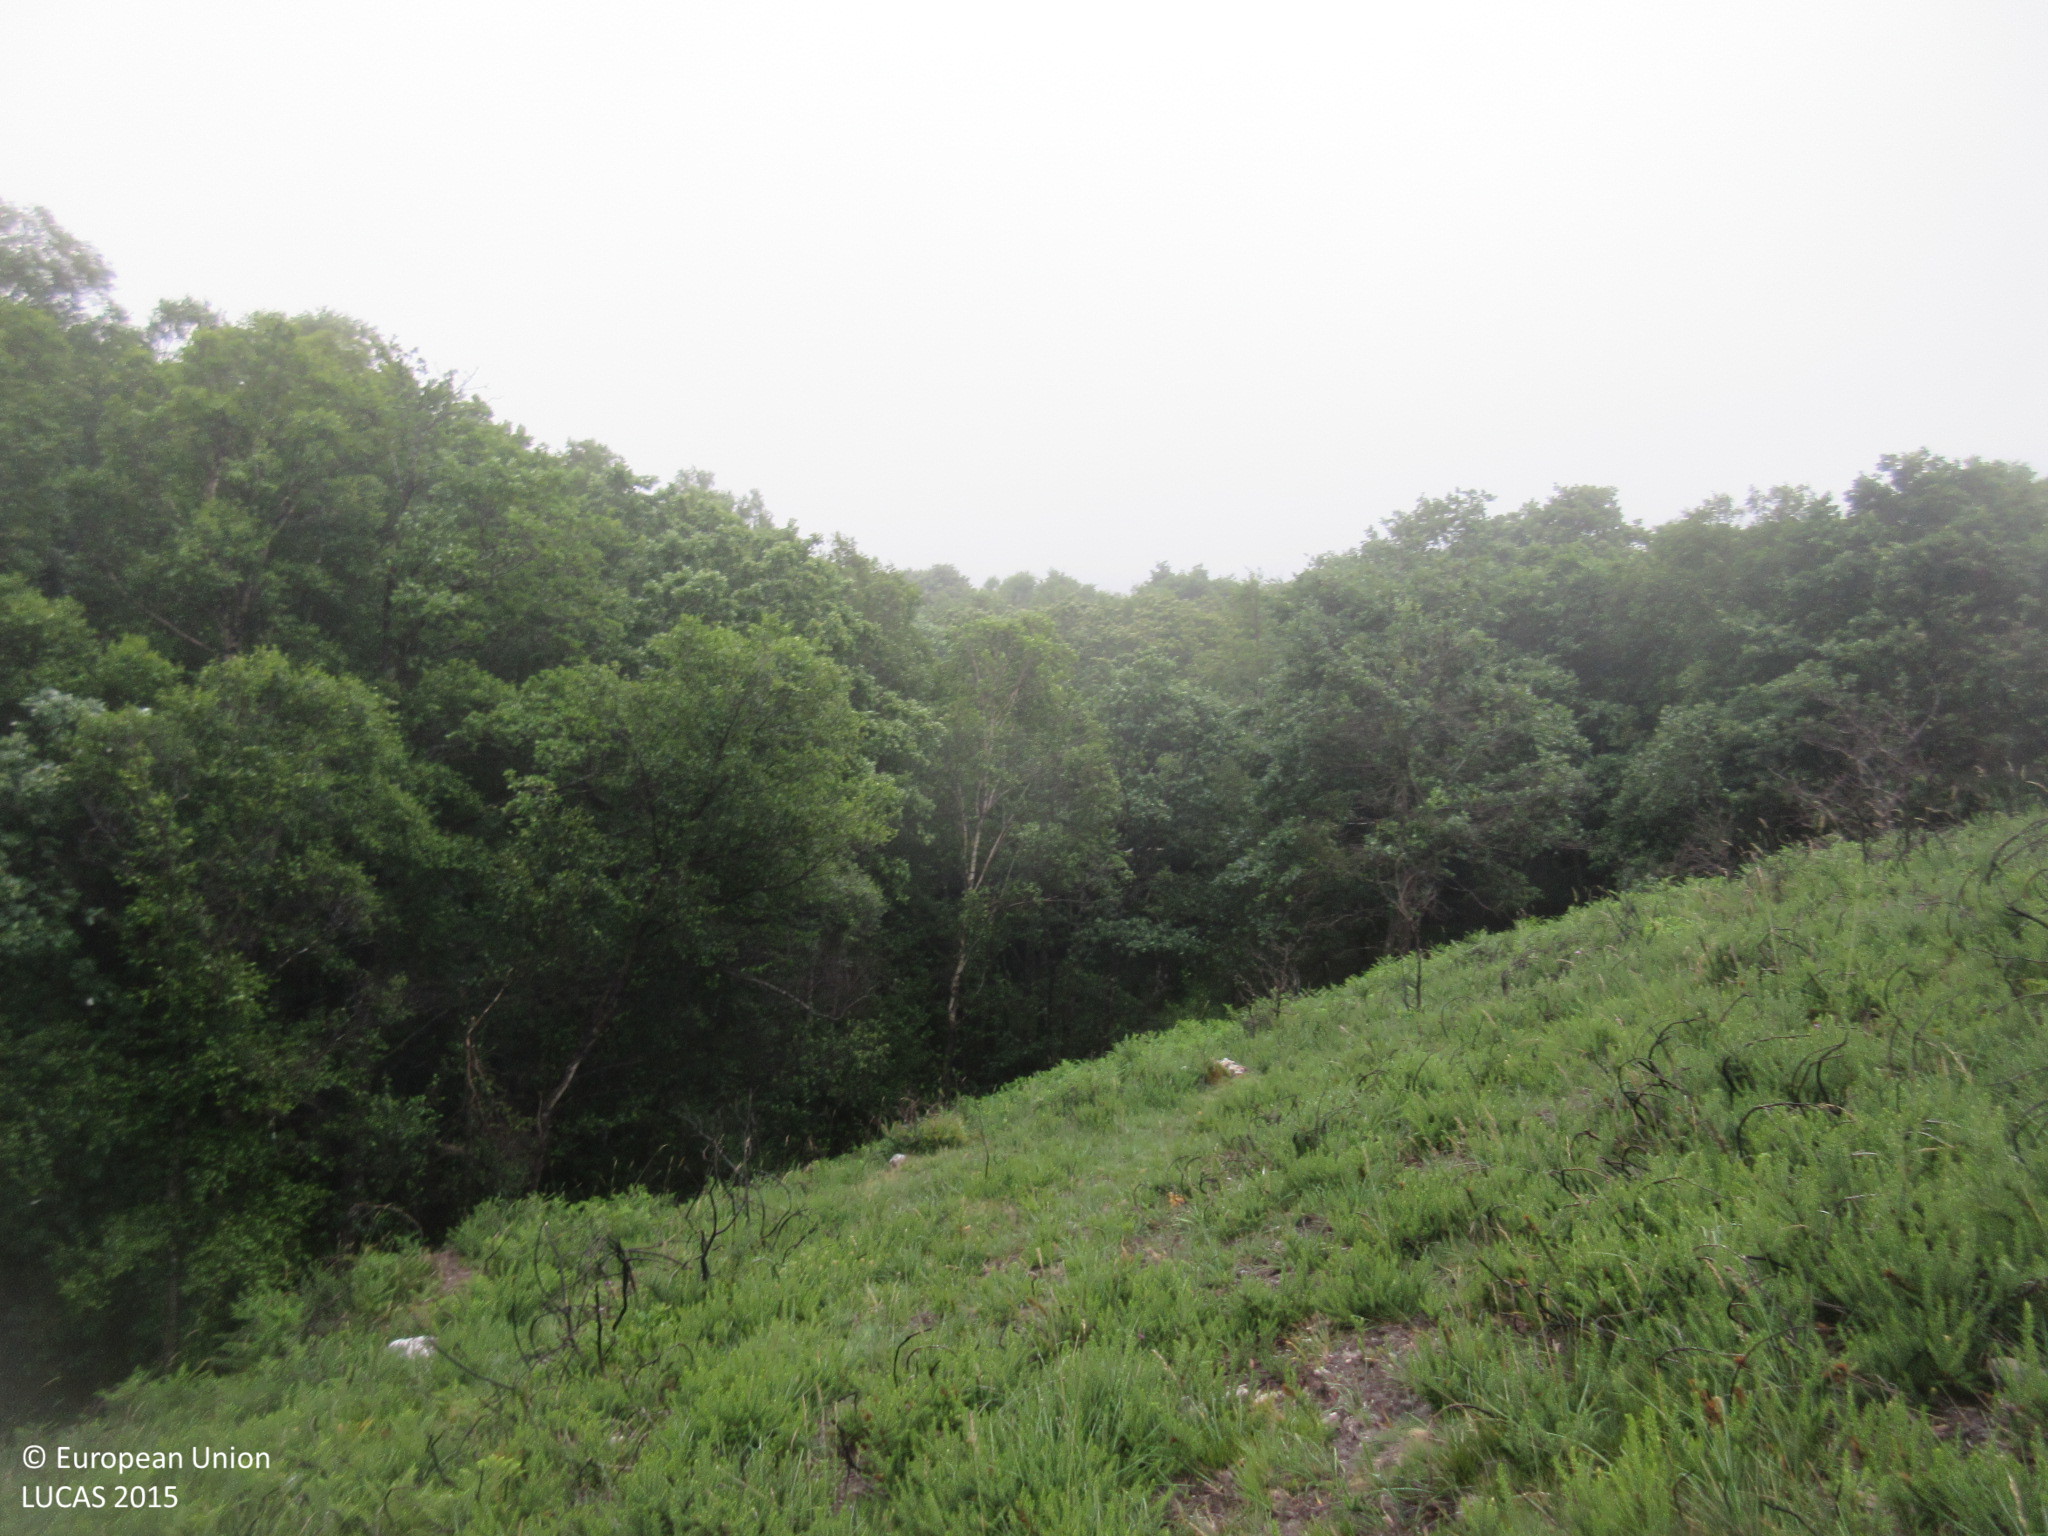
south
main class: Shrubland
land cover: Shrubland without tree cover
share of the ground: > 75 %
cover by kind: shrubs 75 %, herbaceous plants 20 %, unconsolidated bare surface 5 %
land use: Agriculture (excluding fallow land and kitchen gardens)
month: July
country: ES
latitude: 43.0433
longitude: -3.9056
